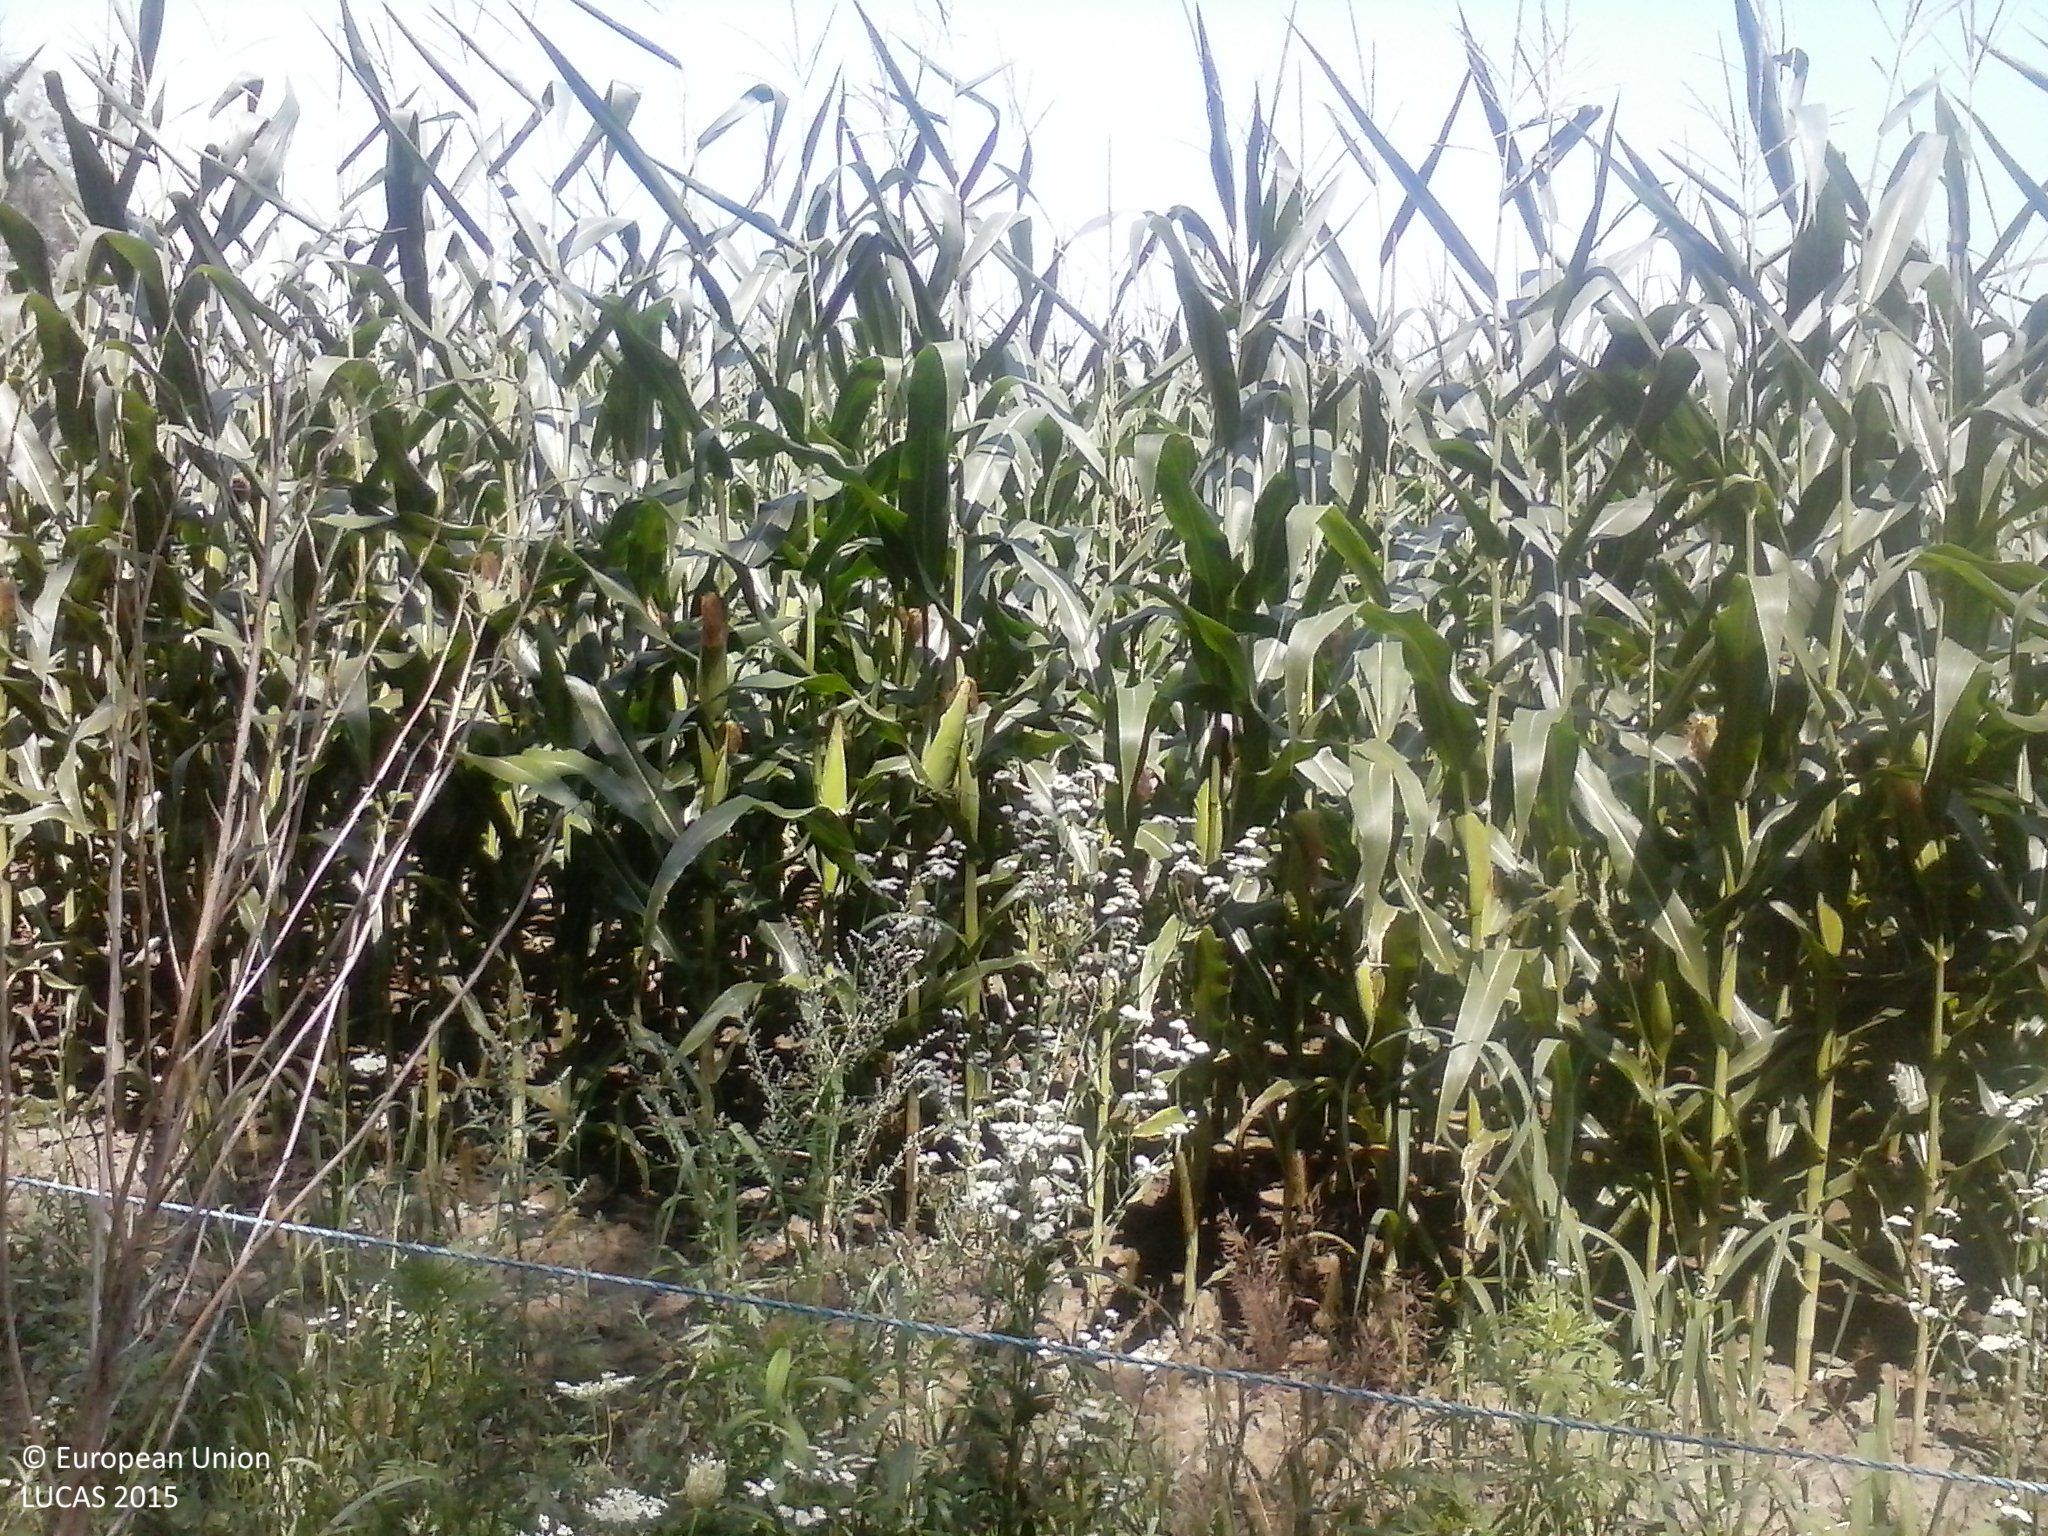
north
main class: Cropland
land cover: Maize
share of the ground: > 75 %
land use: Agriculture (excluding fallow land and kitchen gardens)
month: August
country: HU
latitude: 45.8993
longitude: 17.8540
